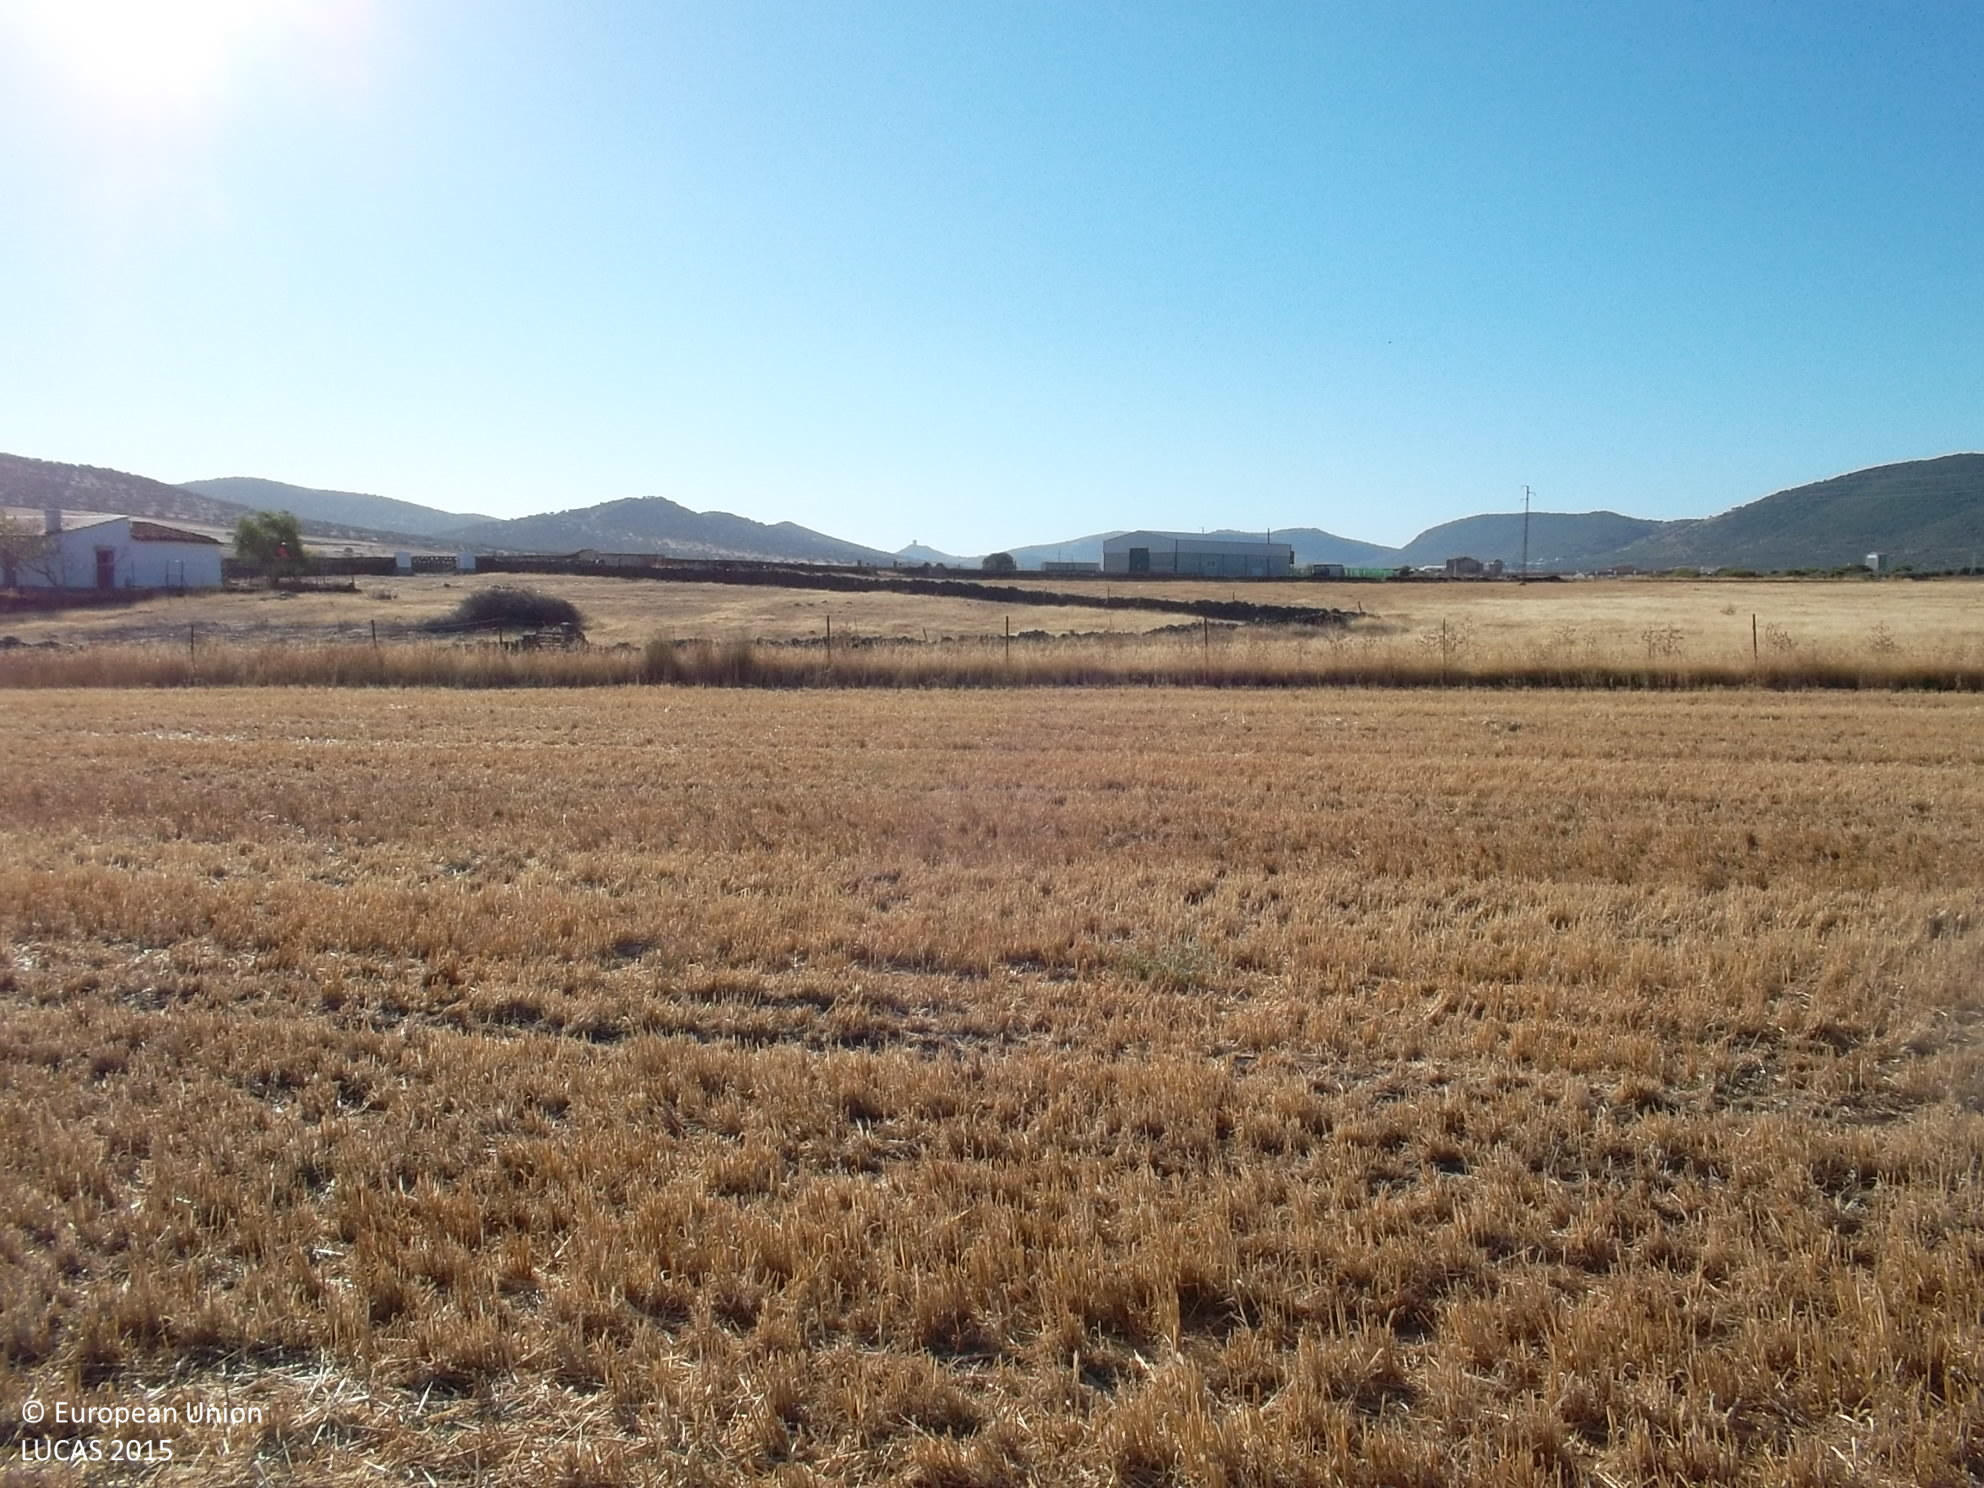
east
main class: Cropland
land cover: Mixed cereals for fodder
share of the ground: < 10 %
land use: Agriculture (excluding fallow land and kitchen gardens)
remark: Harvested field
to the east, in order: Mixed cereals for fodder; Fences; Dry stone walls; Grassland without tree/shrub cover; Dry stone walls; Artificial constructions in urban areas; Dry stone walls; Grassland without tree/shrub cover; Dry stone walls; Tracks; Dry stone walls; Grassland without tree/shrub cover; Dry stone walls; Tracks; Grassland without tree/shrub cover
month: August
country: ES
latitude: 38.5547
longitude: -6.6619
